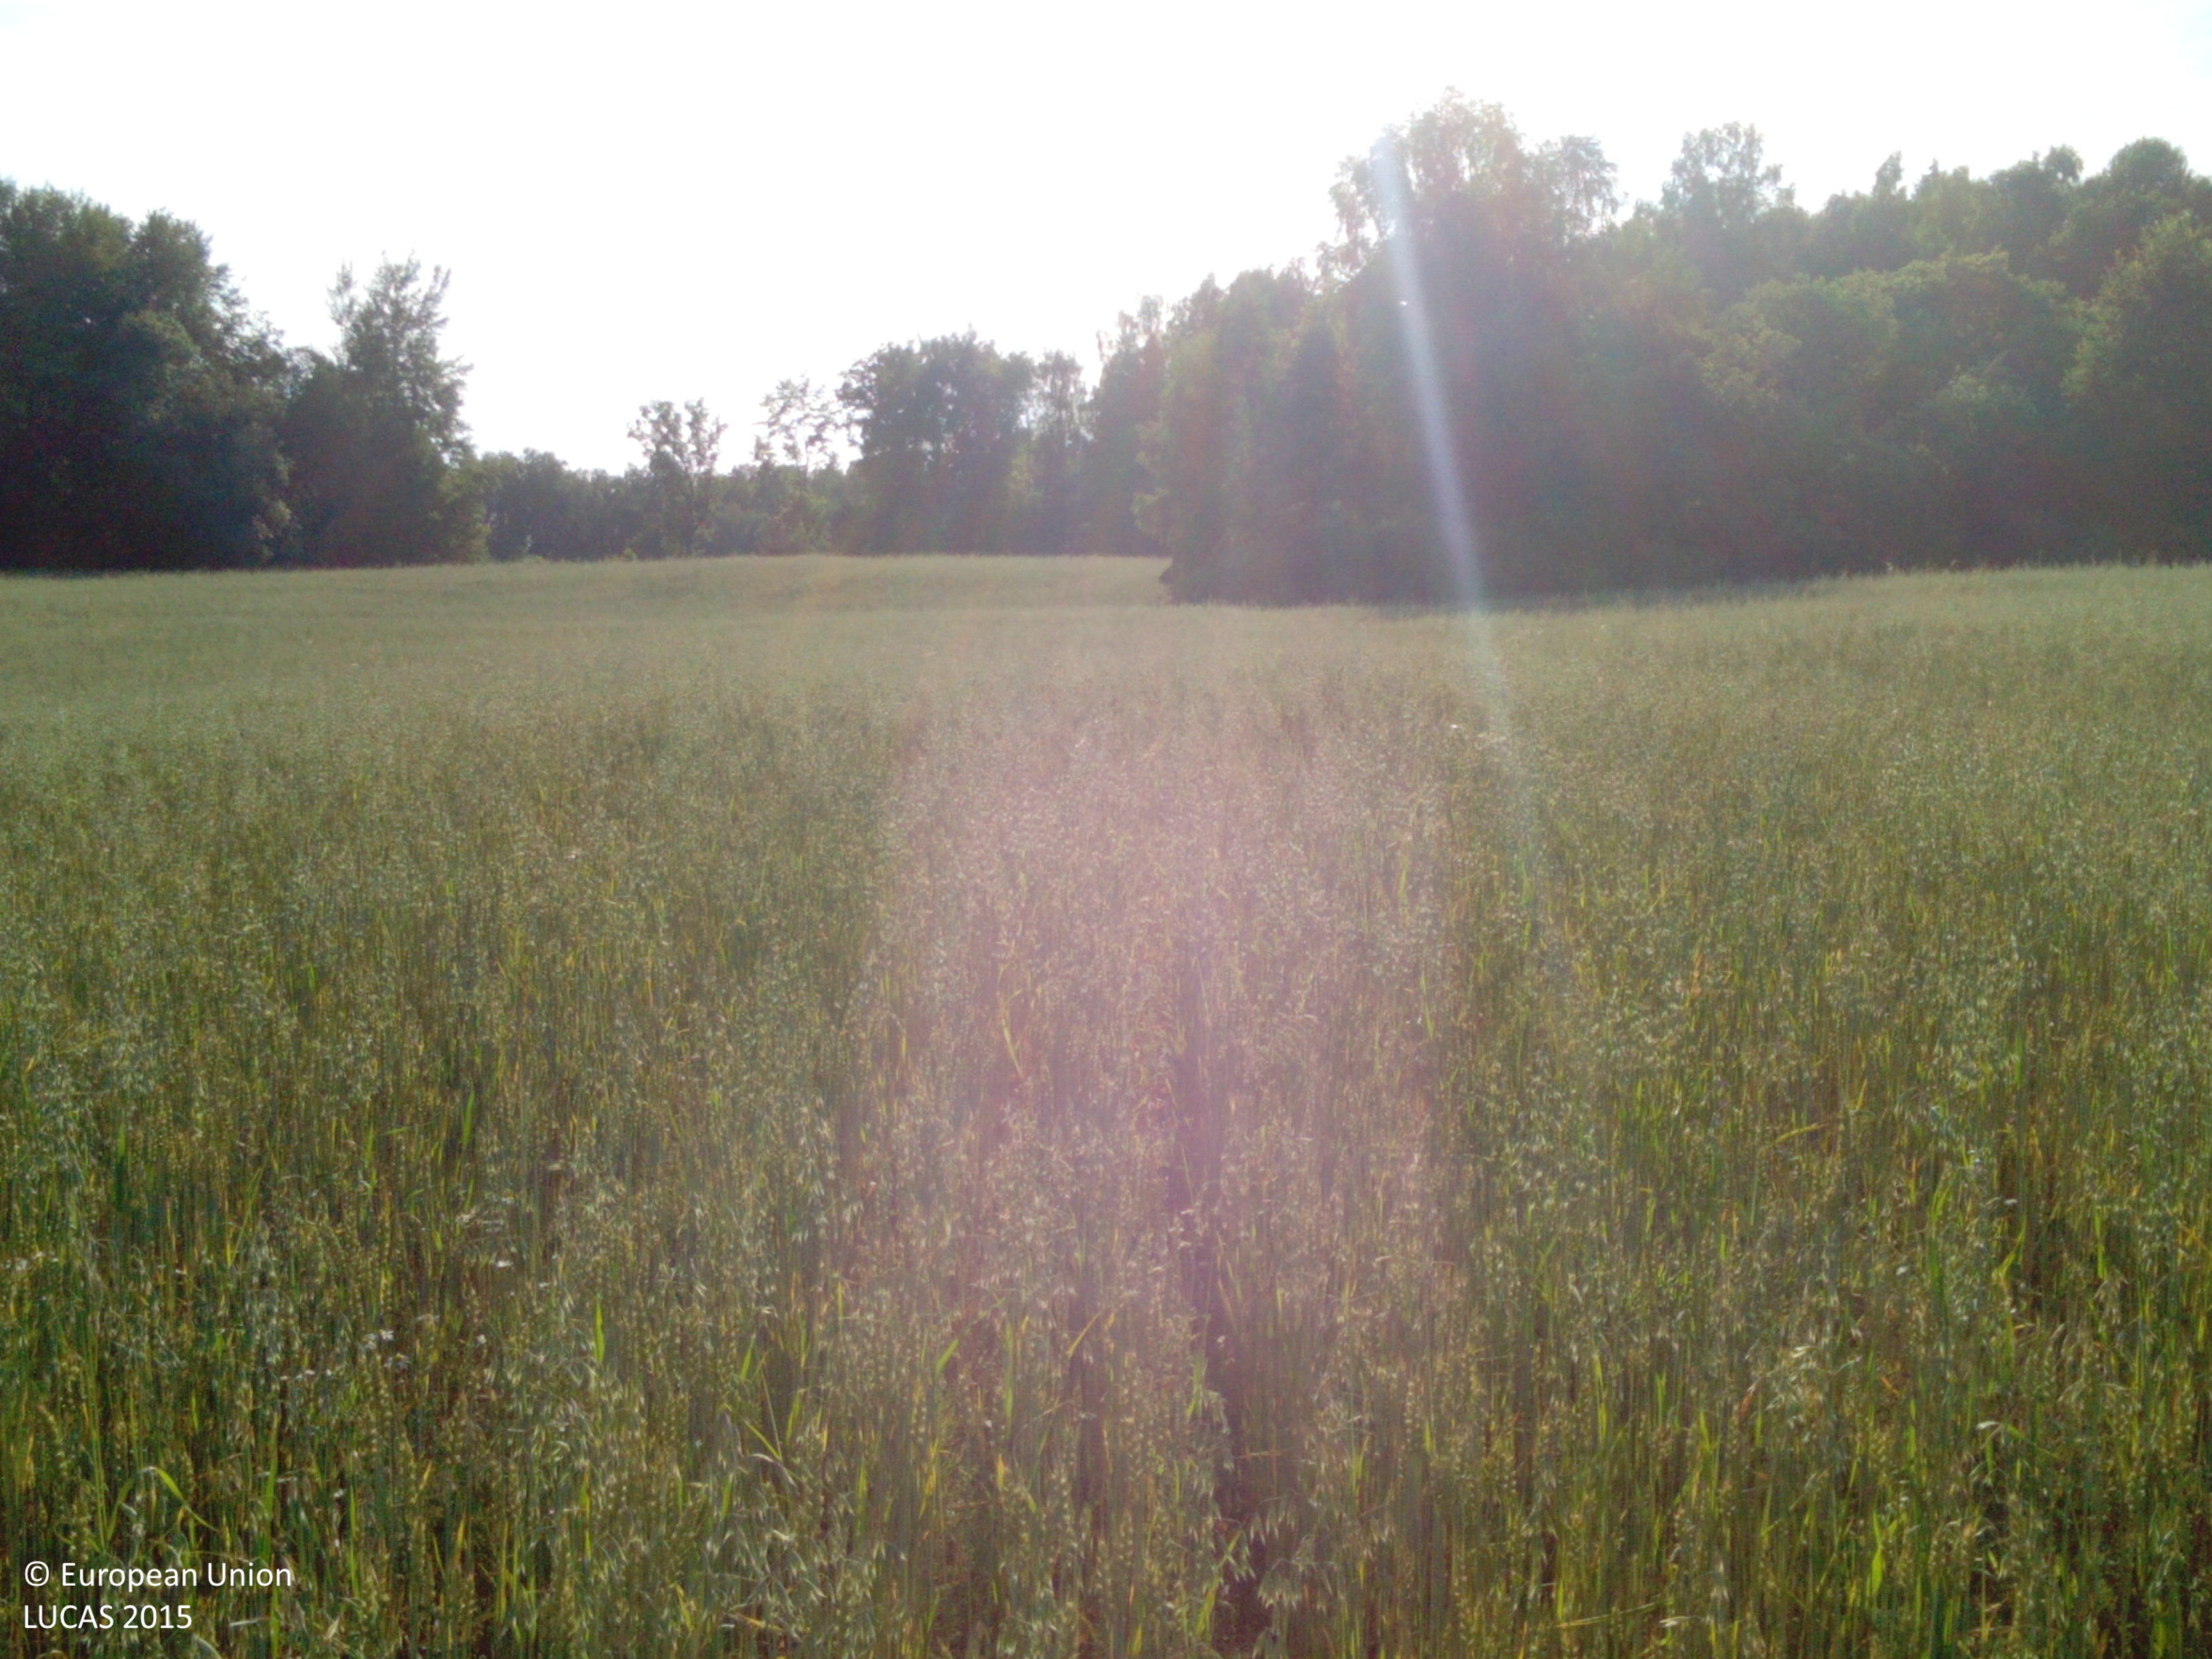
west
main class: Cropland
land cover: Common wheat
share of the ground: > 75 %
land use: Agriculture (excluding fallow land and kitchen gardens)
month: August
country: LV
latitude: 56.8568
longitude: 21.8369
